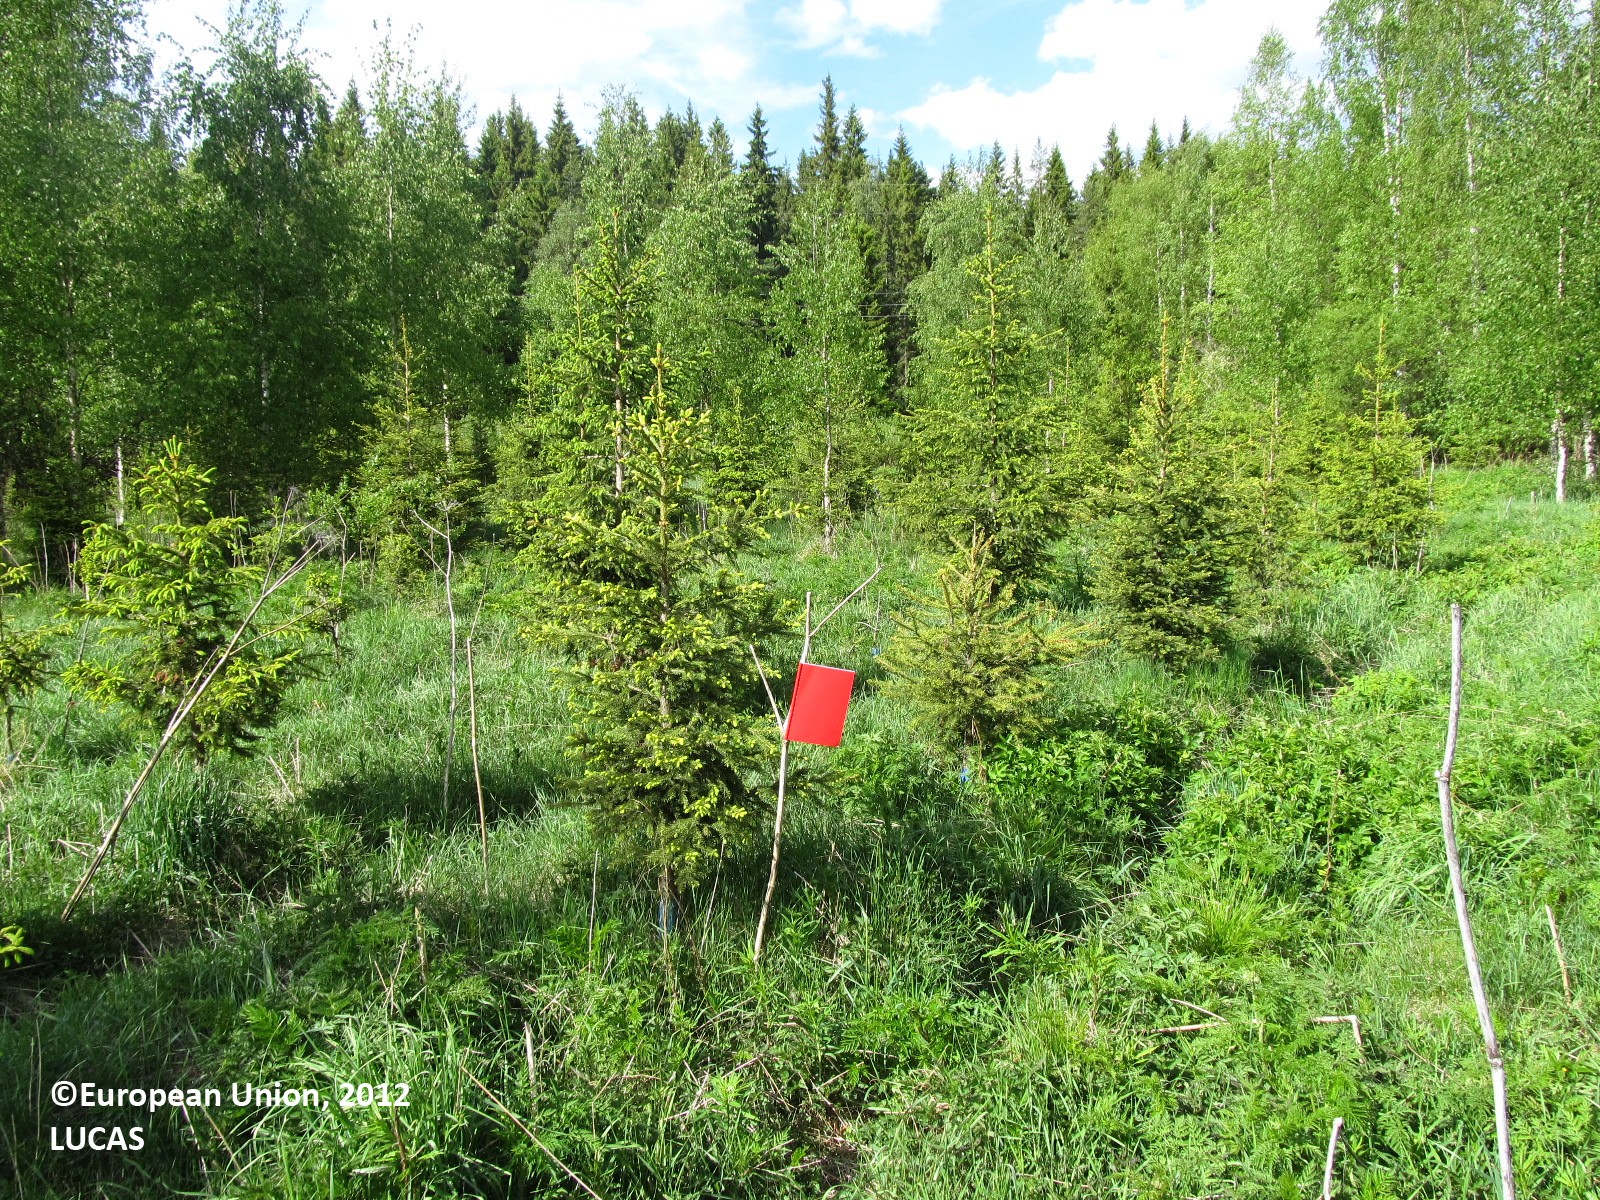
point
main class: Woodland
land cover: Spruce dominated coniferous woodland
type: boreal forest
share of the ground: 10 - 25 %
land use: Forestry
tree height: < 5 m
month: June
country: FI
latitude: 62.5294
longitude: 28.6469
